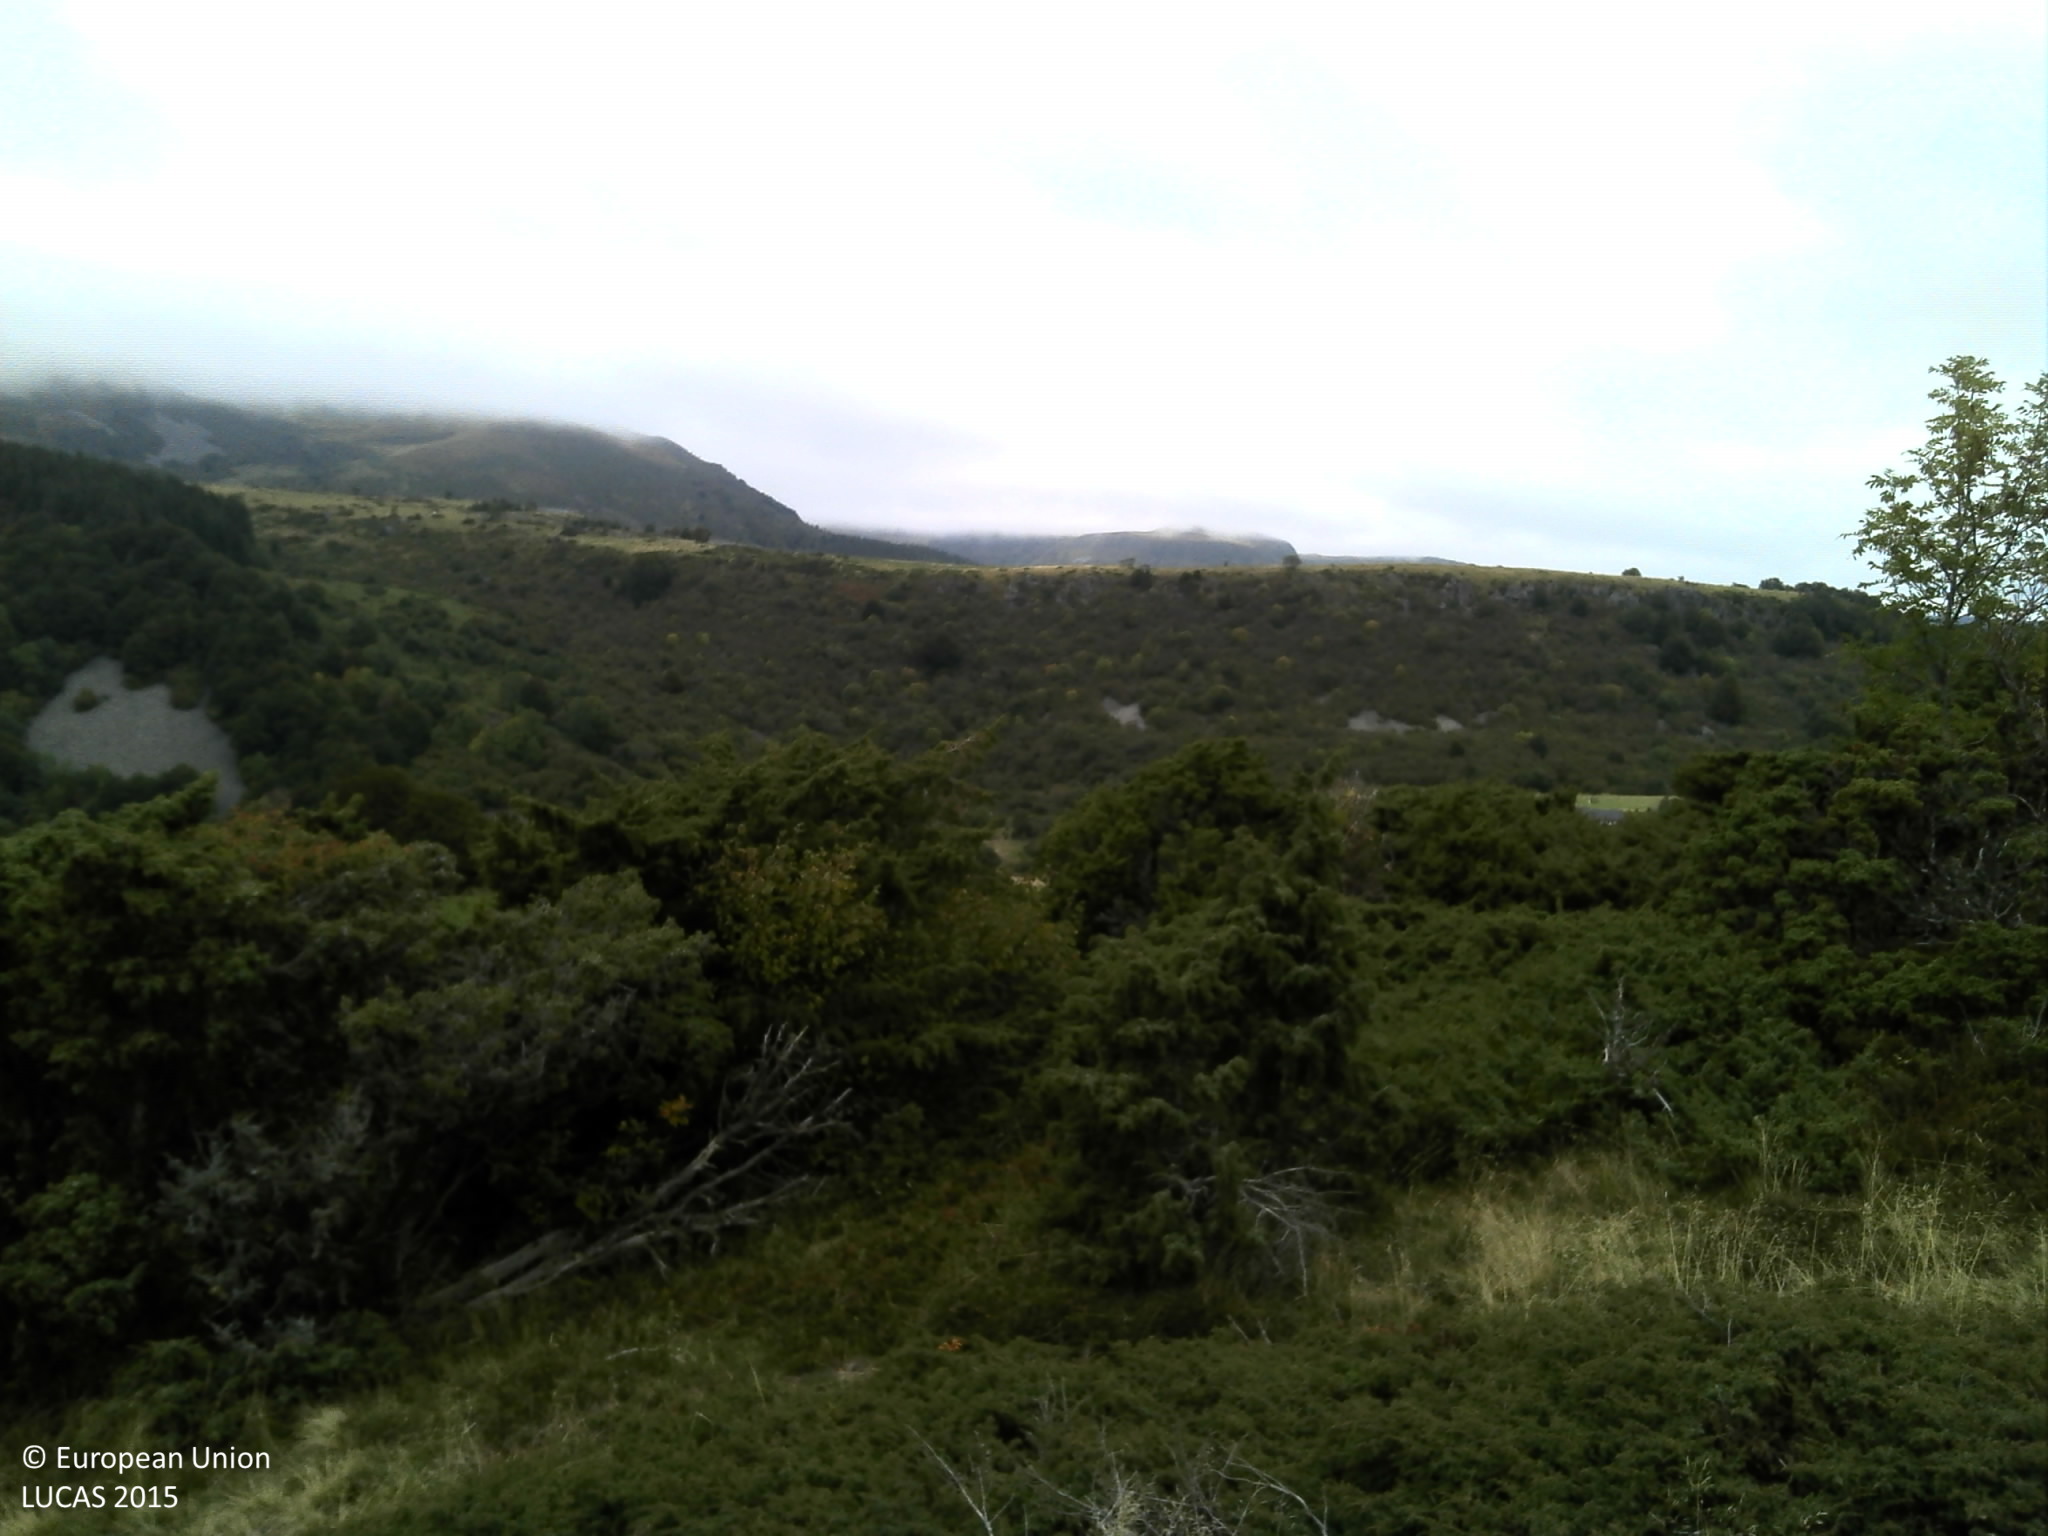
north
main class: Shrubland
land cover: Shrubland without tree cover
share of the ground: > 75 %
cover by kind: shrubs 90 %, herbaceous plants 10 %
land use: Agriculture (excluding fallow land and kitchen gardens)
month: September
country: FR
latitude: 45.5522
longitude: 2.8648
